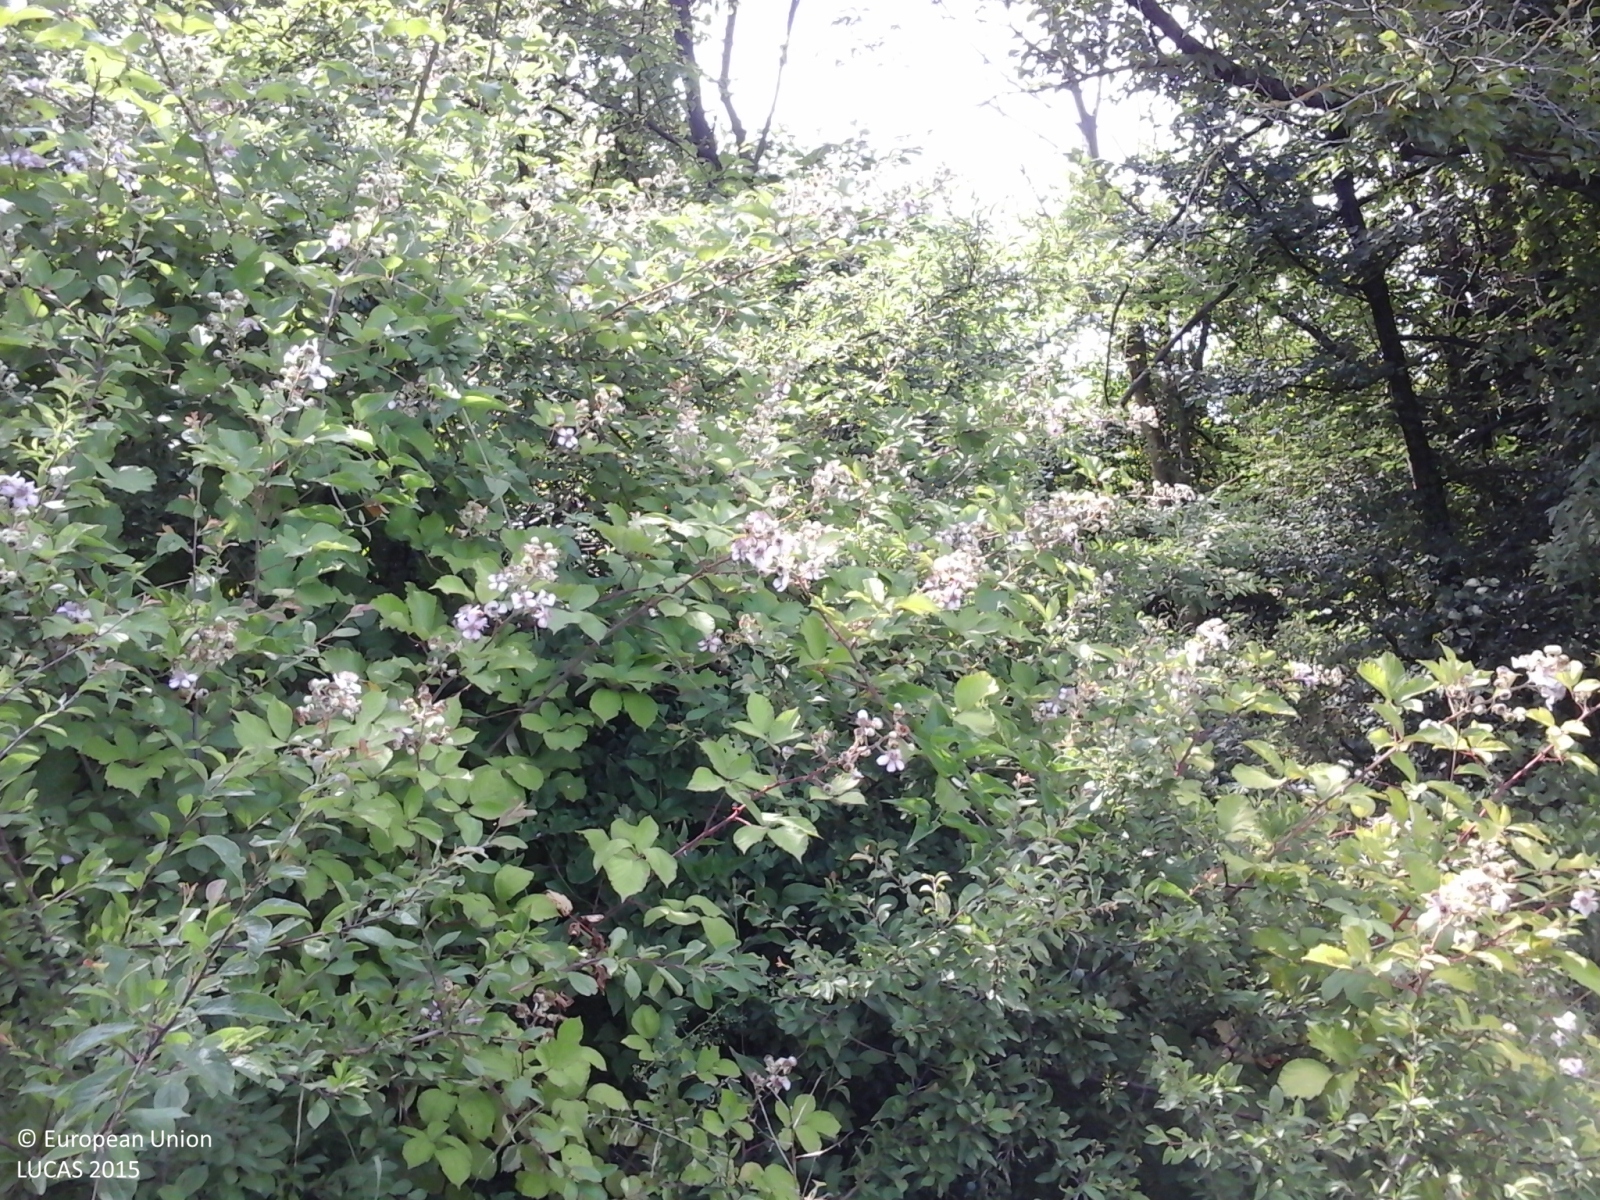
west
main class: Woodland
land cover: Broadleaved woodland
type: thermophilous deciduous forest
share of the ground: > 75 %
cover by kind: broadleaved forest trees 70 %, shrubs 30 %
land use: Forestry
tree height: > 5 m
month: June
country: IT
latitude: 44.8554
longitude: 9.9116
